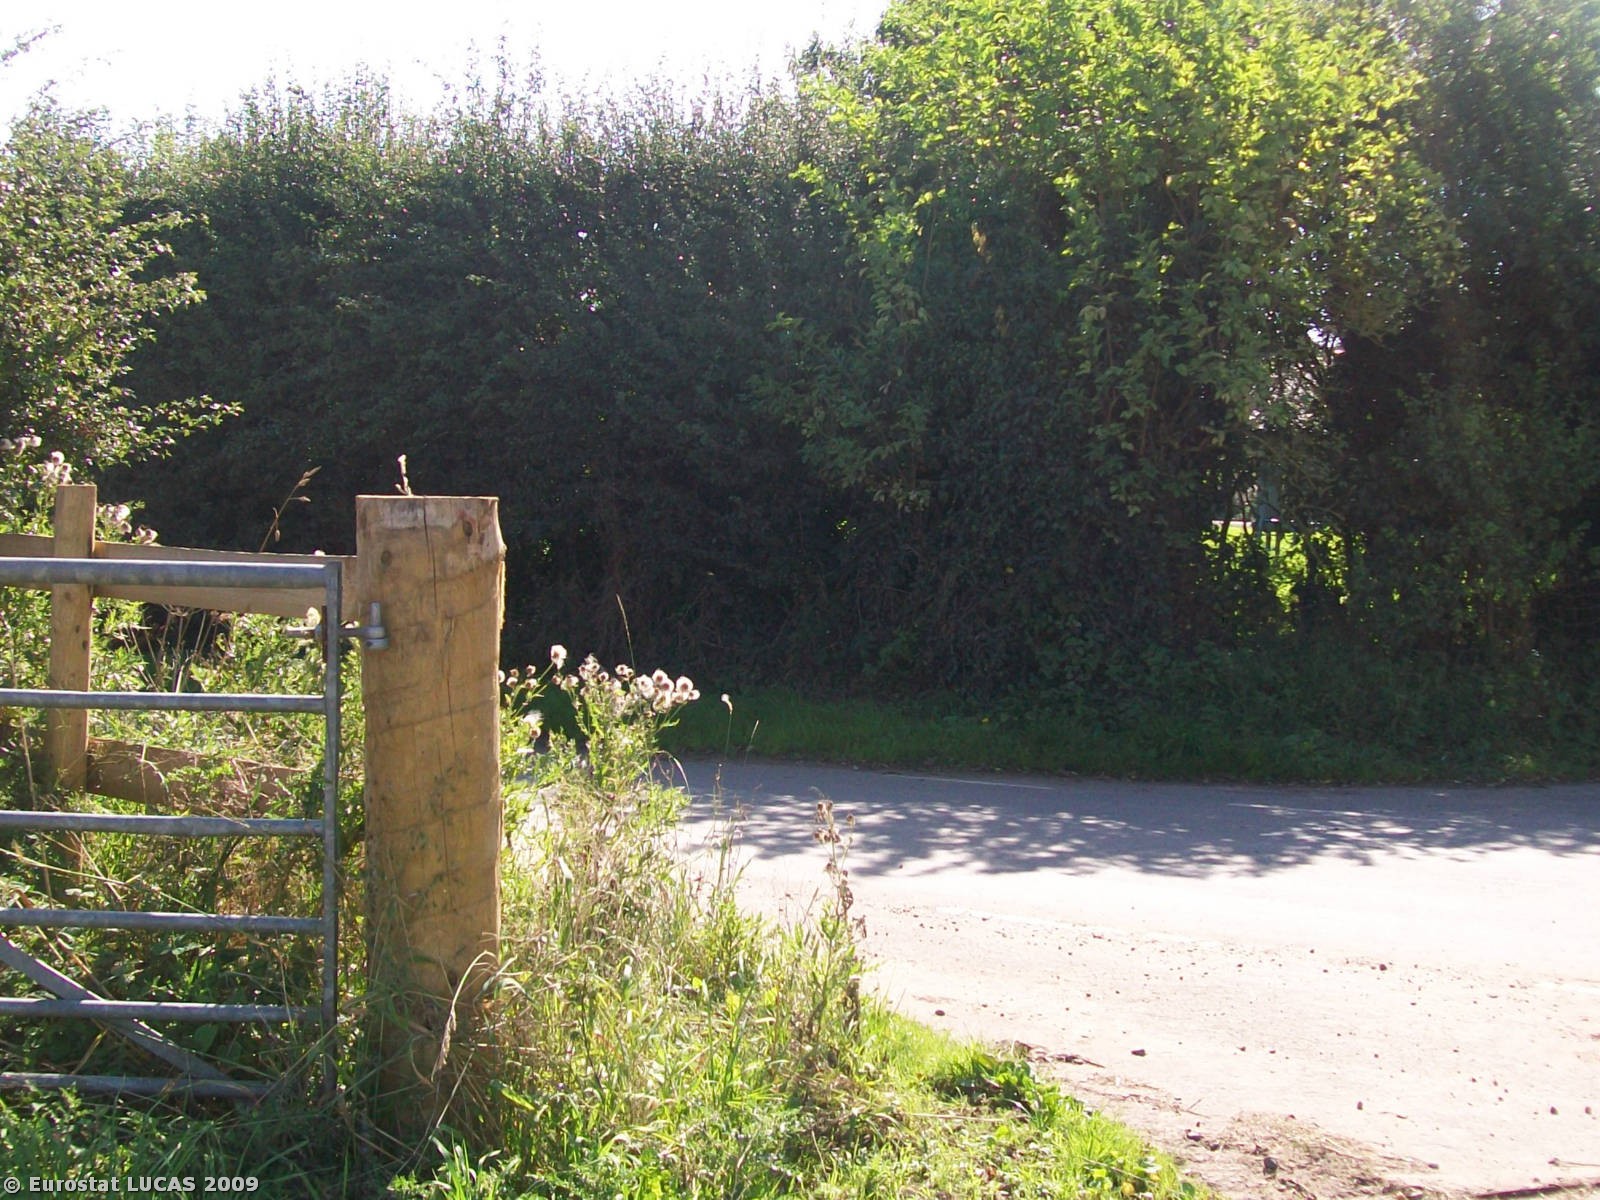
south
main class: Cropland
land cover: Rape and turnip rape
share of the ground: > 75 %
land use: Agriculture (excluding fallow land and kitchen gardens)
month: September
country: GB
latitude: 52.8274
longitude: -2.6391
